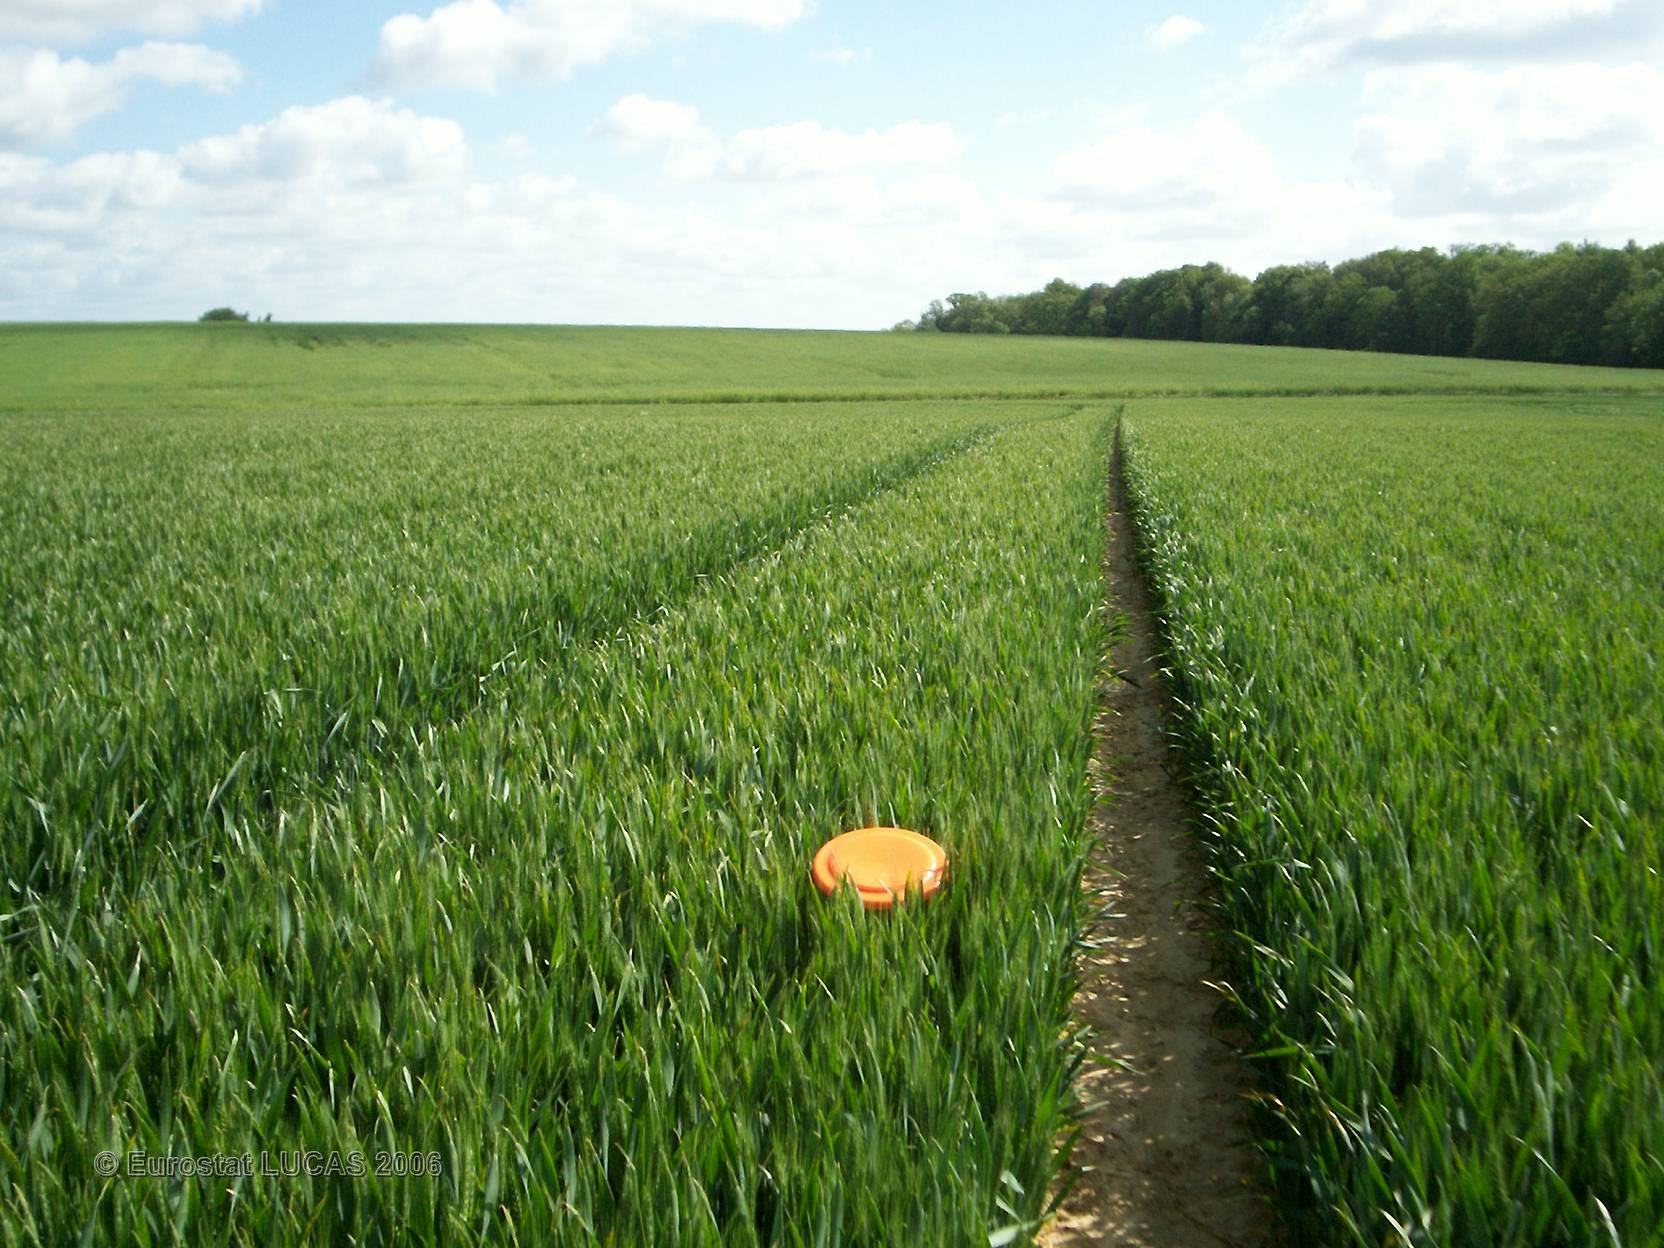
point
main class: Cropland
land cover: Common wheat
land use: Agriculture (excluding fallow land and kitchen gardens)
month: May
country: FR
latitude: 47.5884
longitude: 0.8457
